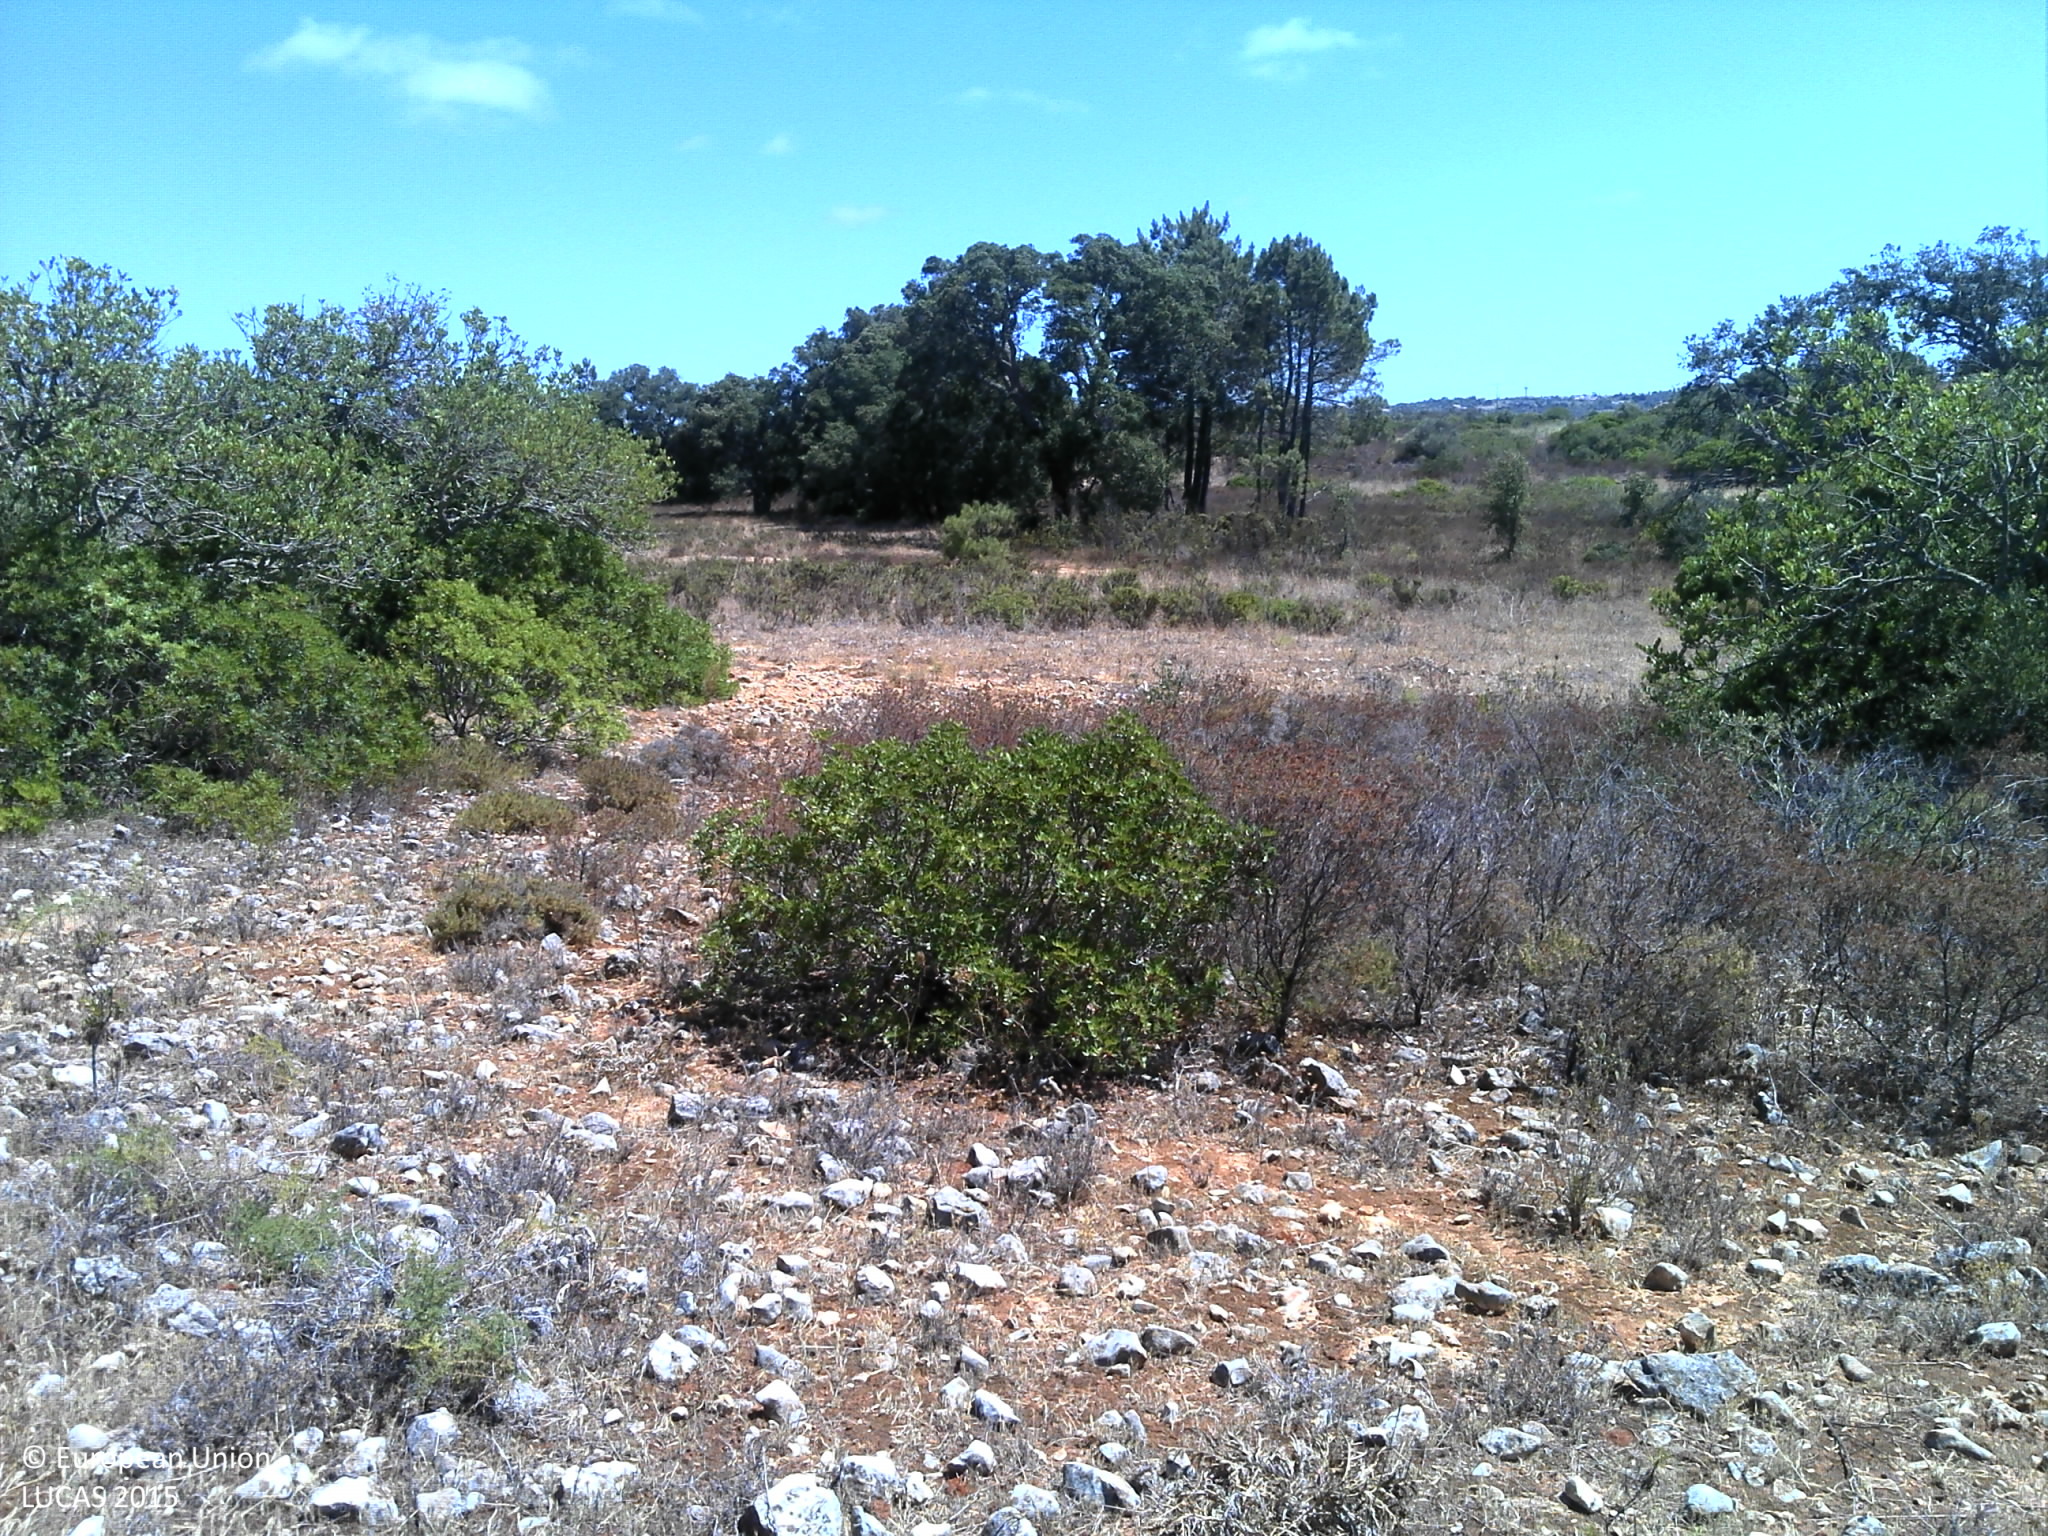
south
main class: Grassland
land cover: Grassland with sparse tree/shrub cover
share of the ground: 50 - 75 %
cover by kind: herbaceous plants 60 %, unconsolidated bare surface 30 %, broadleaved forest trees 5 %, shrubs 5 %
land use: Agriculture (excluding fallow land and kitchen gardens)
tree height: < 5 m
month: July
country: PT
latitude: 37.1260
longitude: -8.7485
